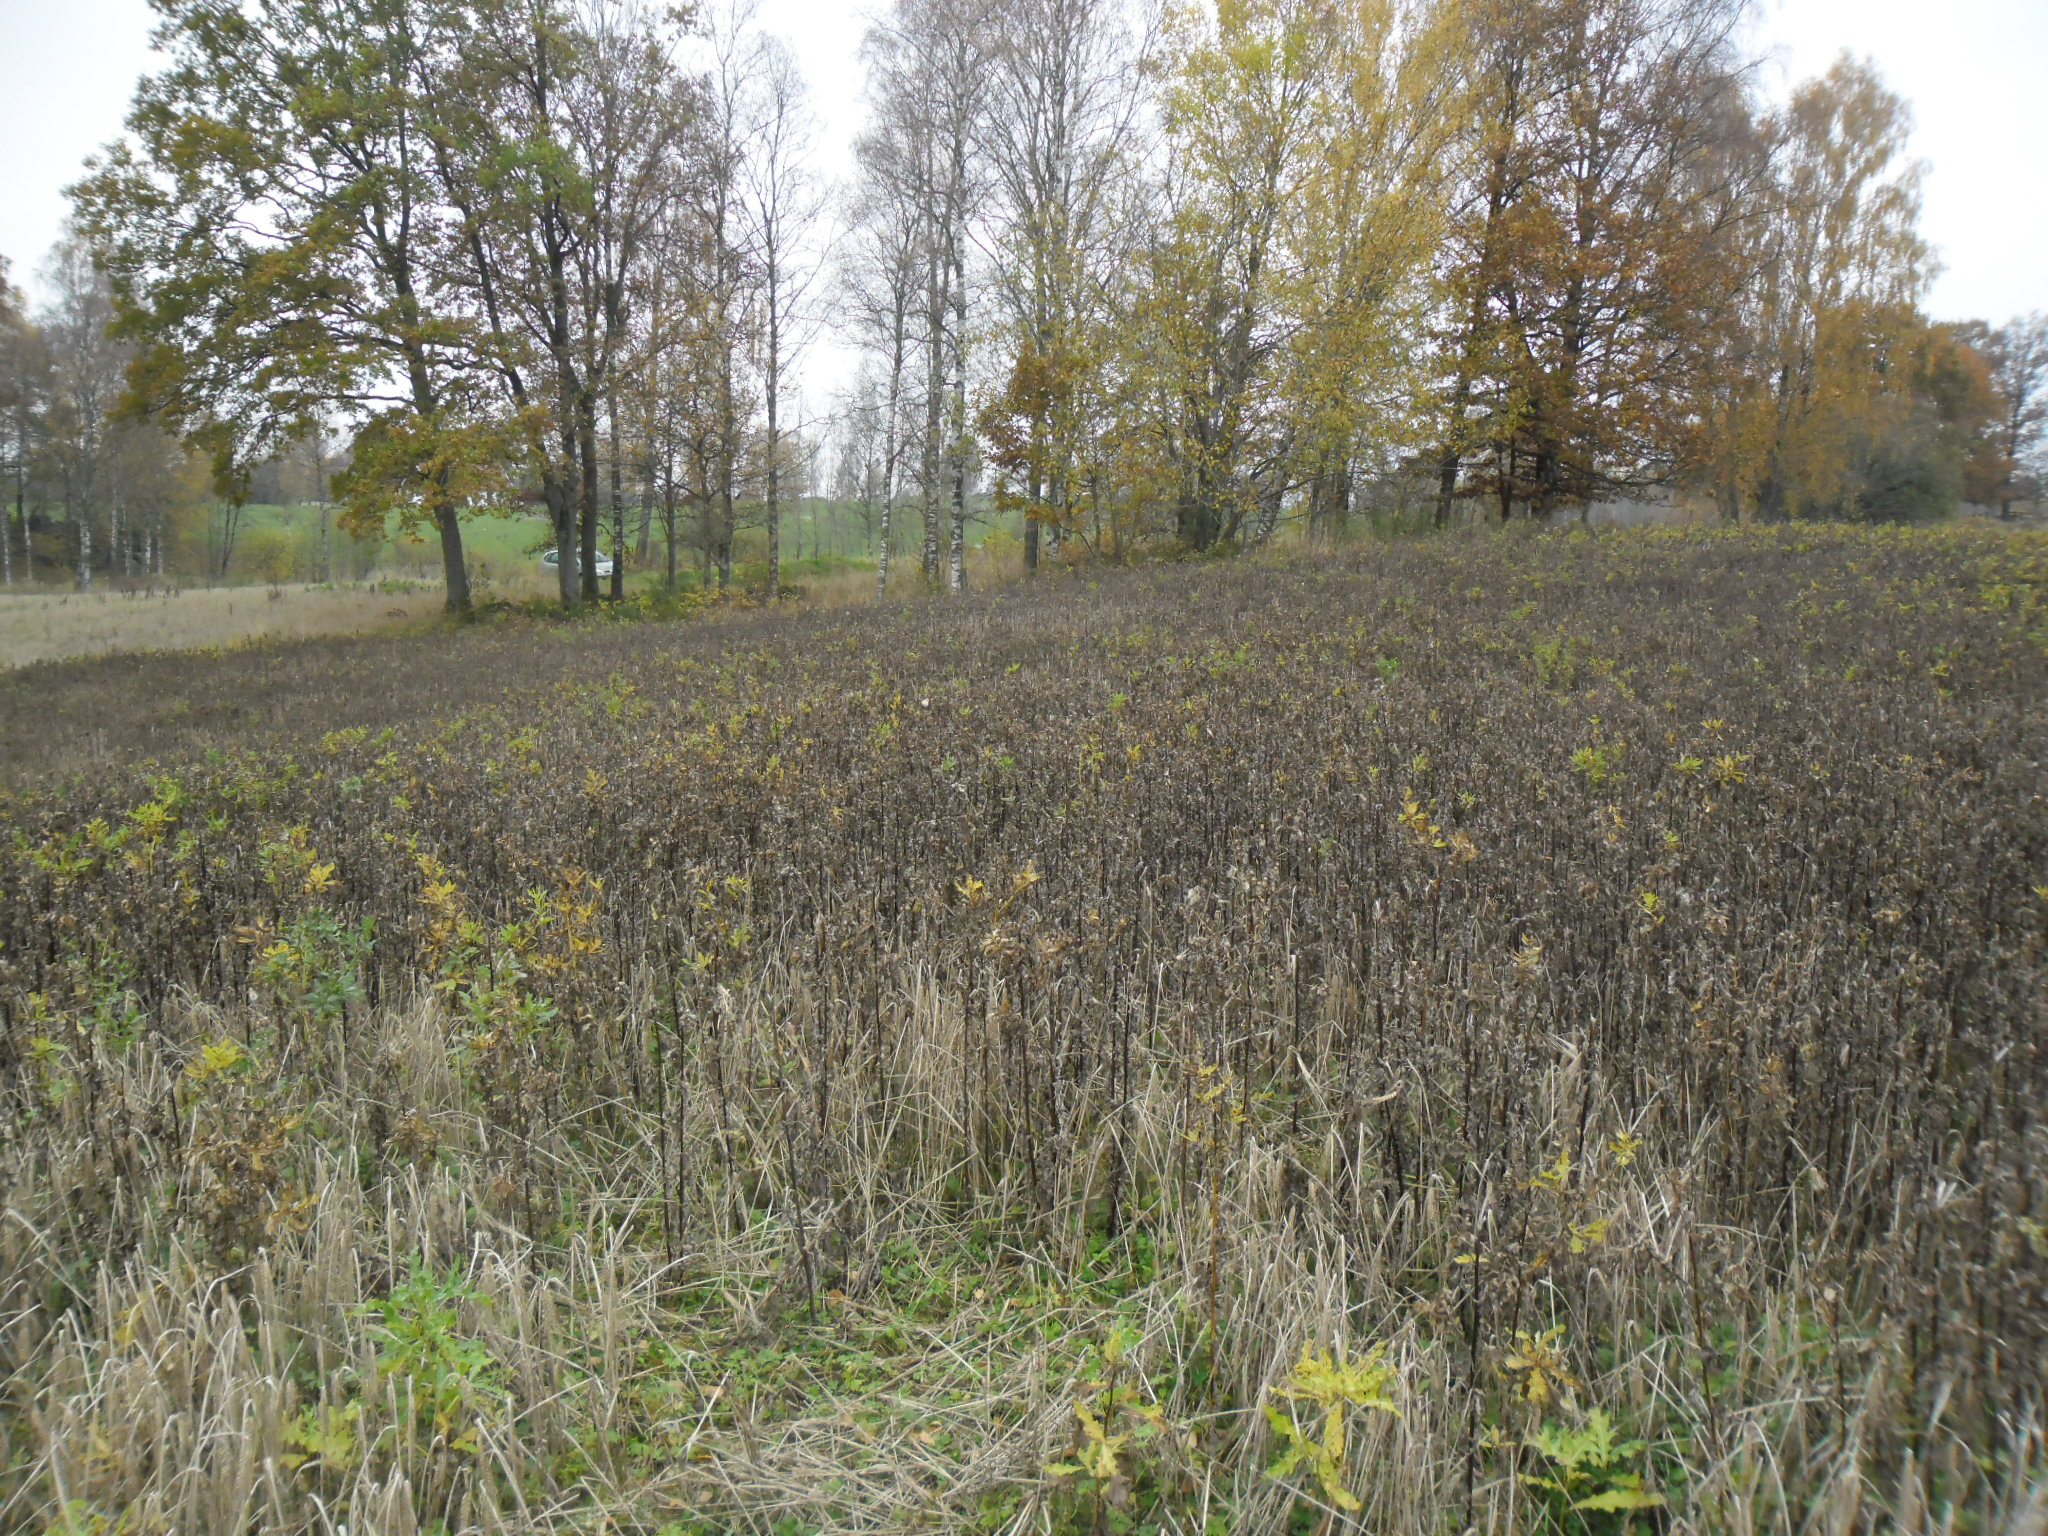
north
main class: Cropland
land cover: Barley
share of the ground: 50 - 75 %
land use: Agriculture (excluding fallow land and kitchen gardens)
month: October
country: SE
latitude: 56.4368
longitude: 13.1597
